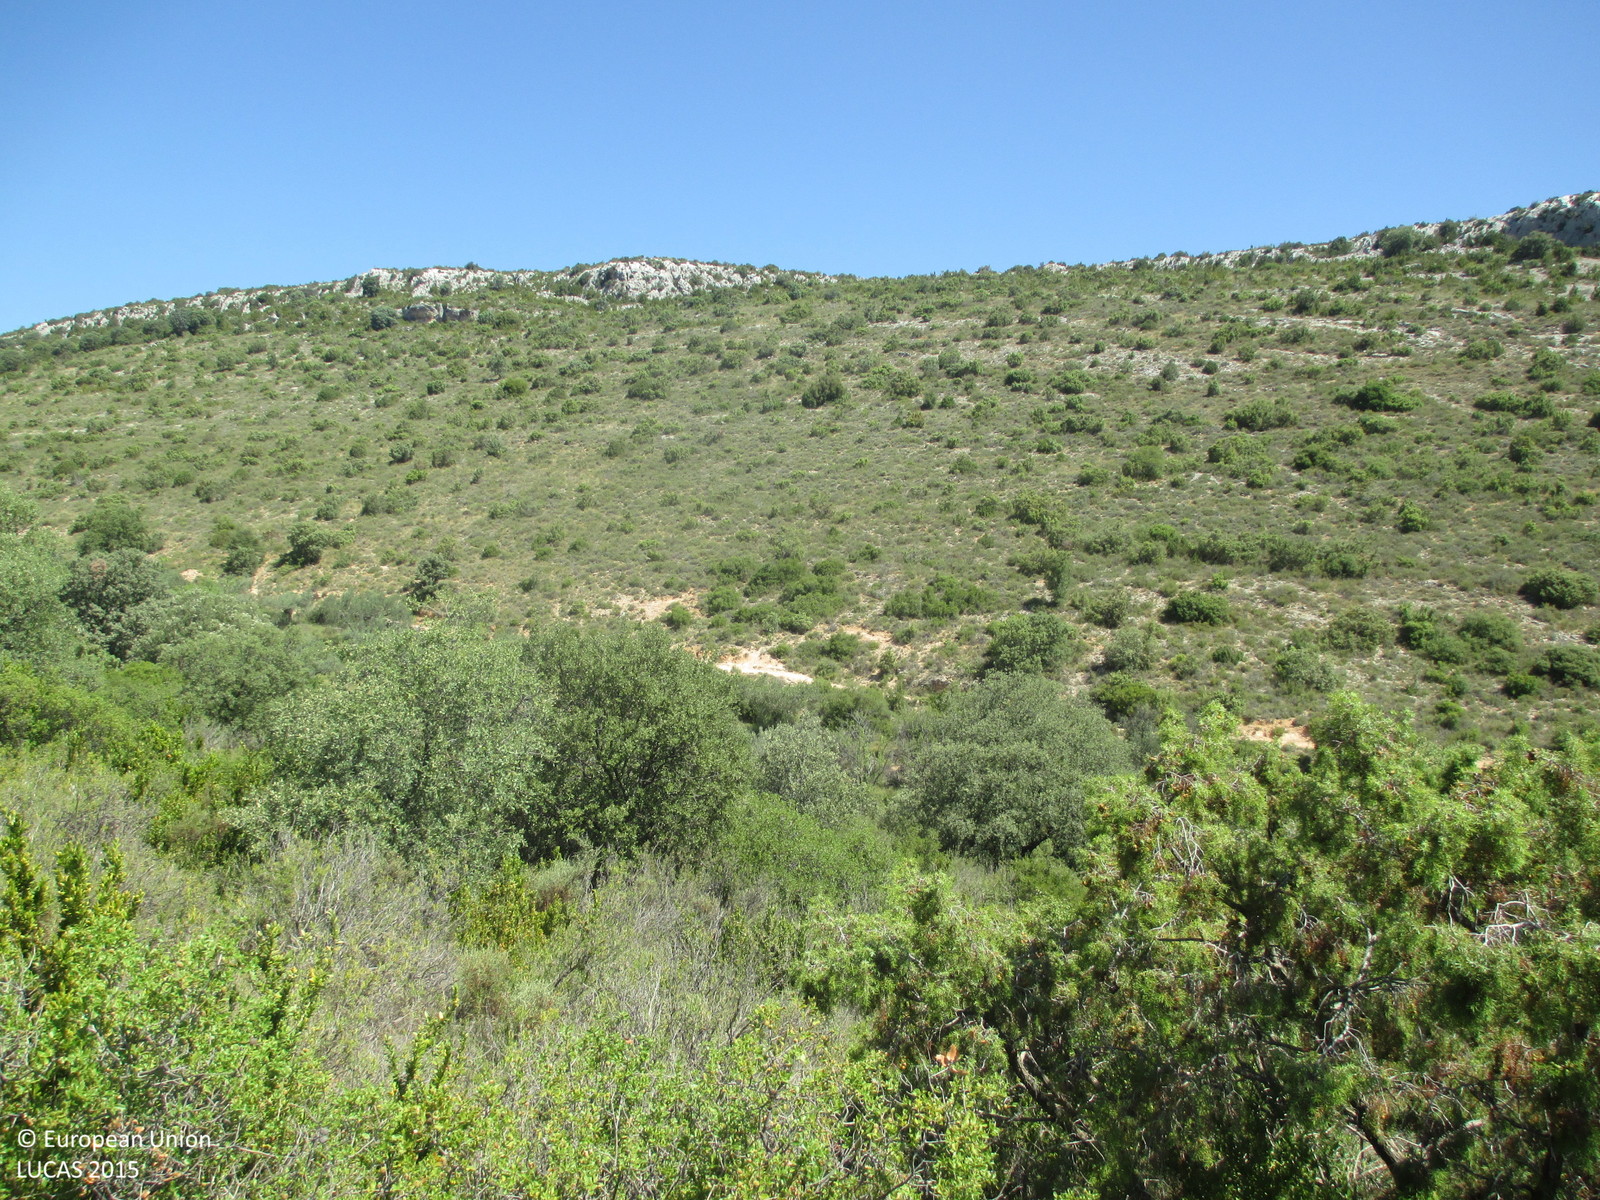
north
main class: Shrubland
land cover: Shrubland without tree cover
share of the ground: > 75 %
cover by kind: shrubs 95 %, herbaceous plants 5 %
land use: Semi-natural and natural areas not in use
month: June
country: ES
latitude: 42.1778
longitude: 0.0163
